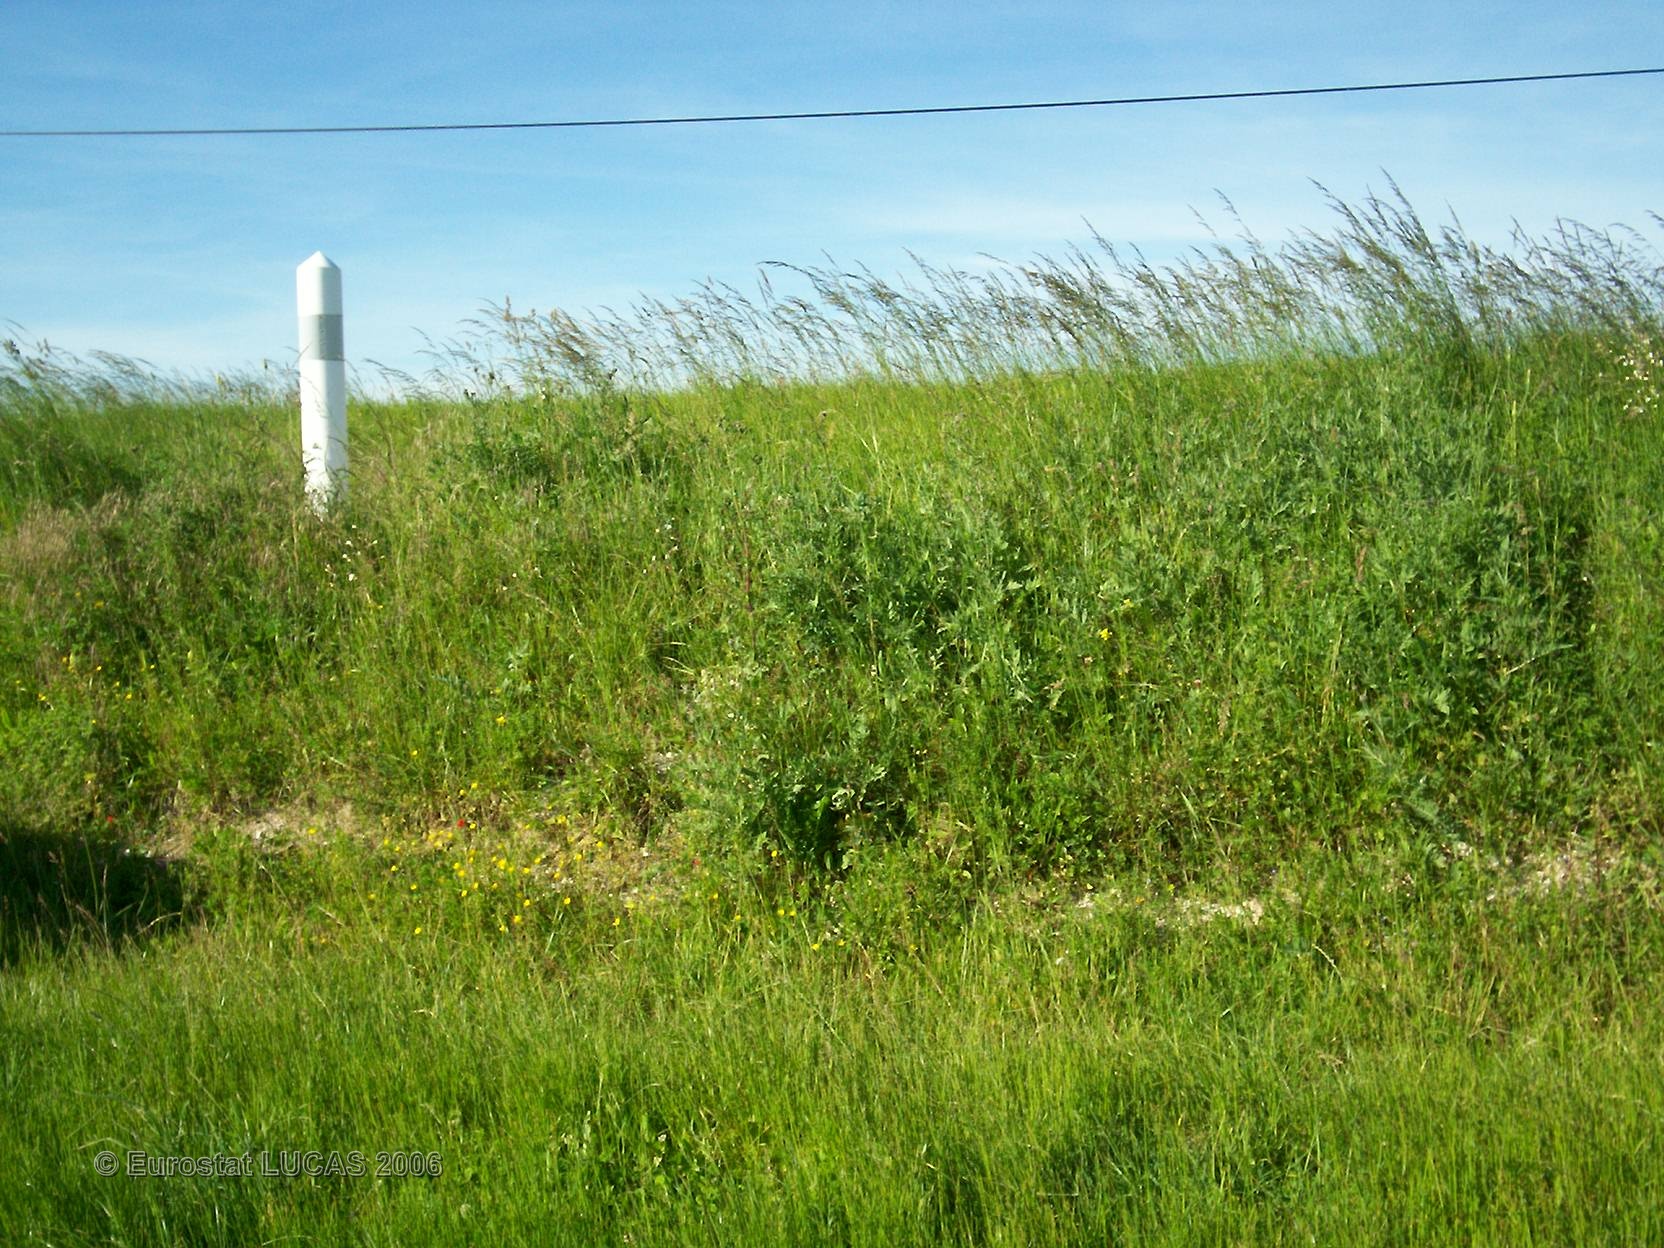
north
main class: Cropland
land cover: Rape and turnip rape
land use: Agriculture (excluding fallow land and kitchen gardens)
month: June
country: FR
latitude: 48.9748
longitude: 4.6005
